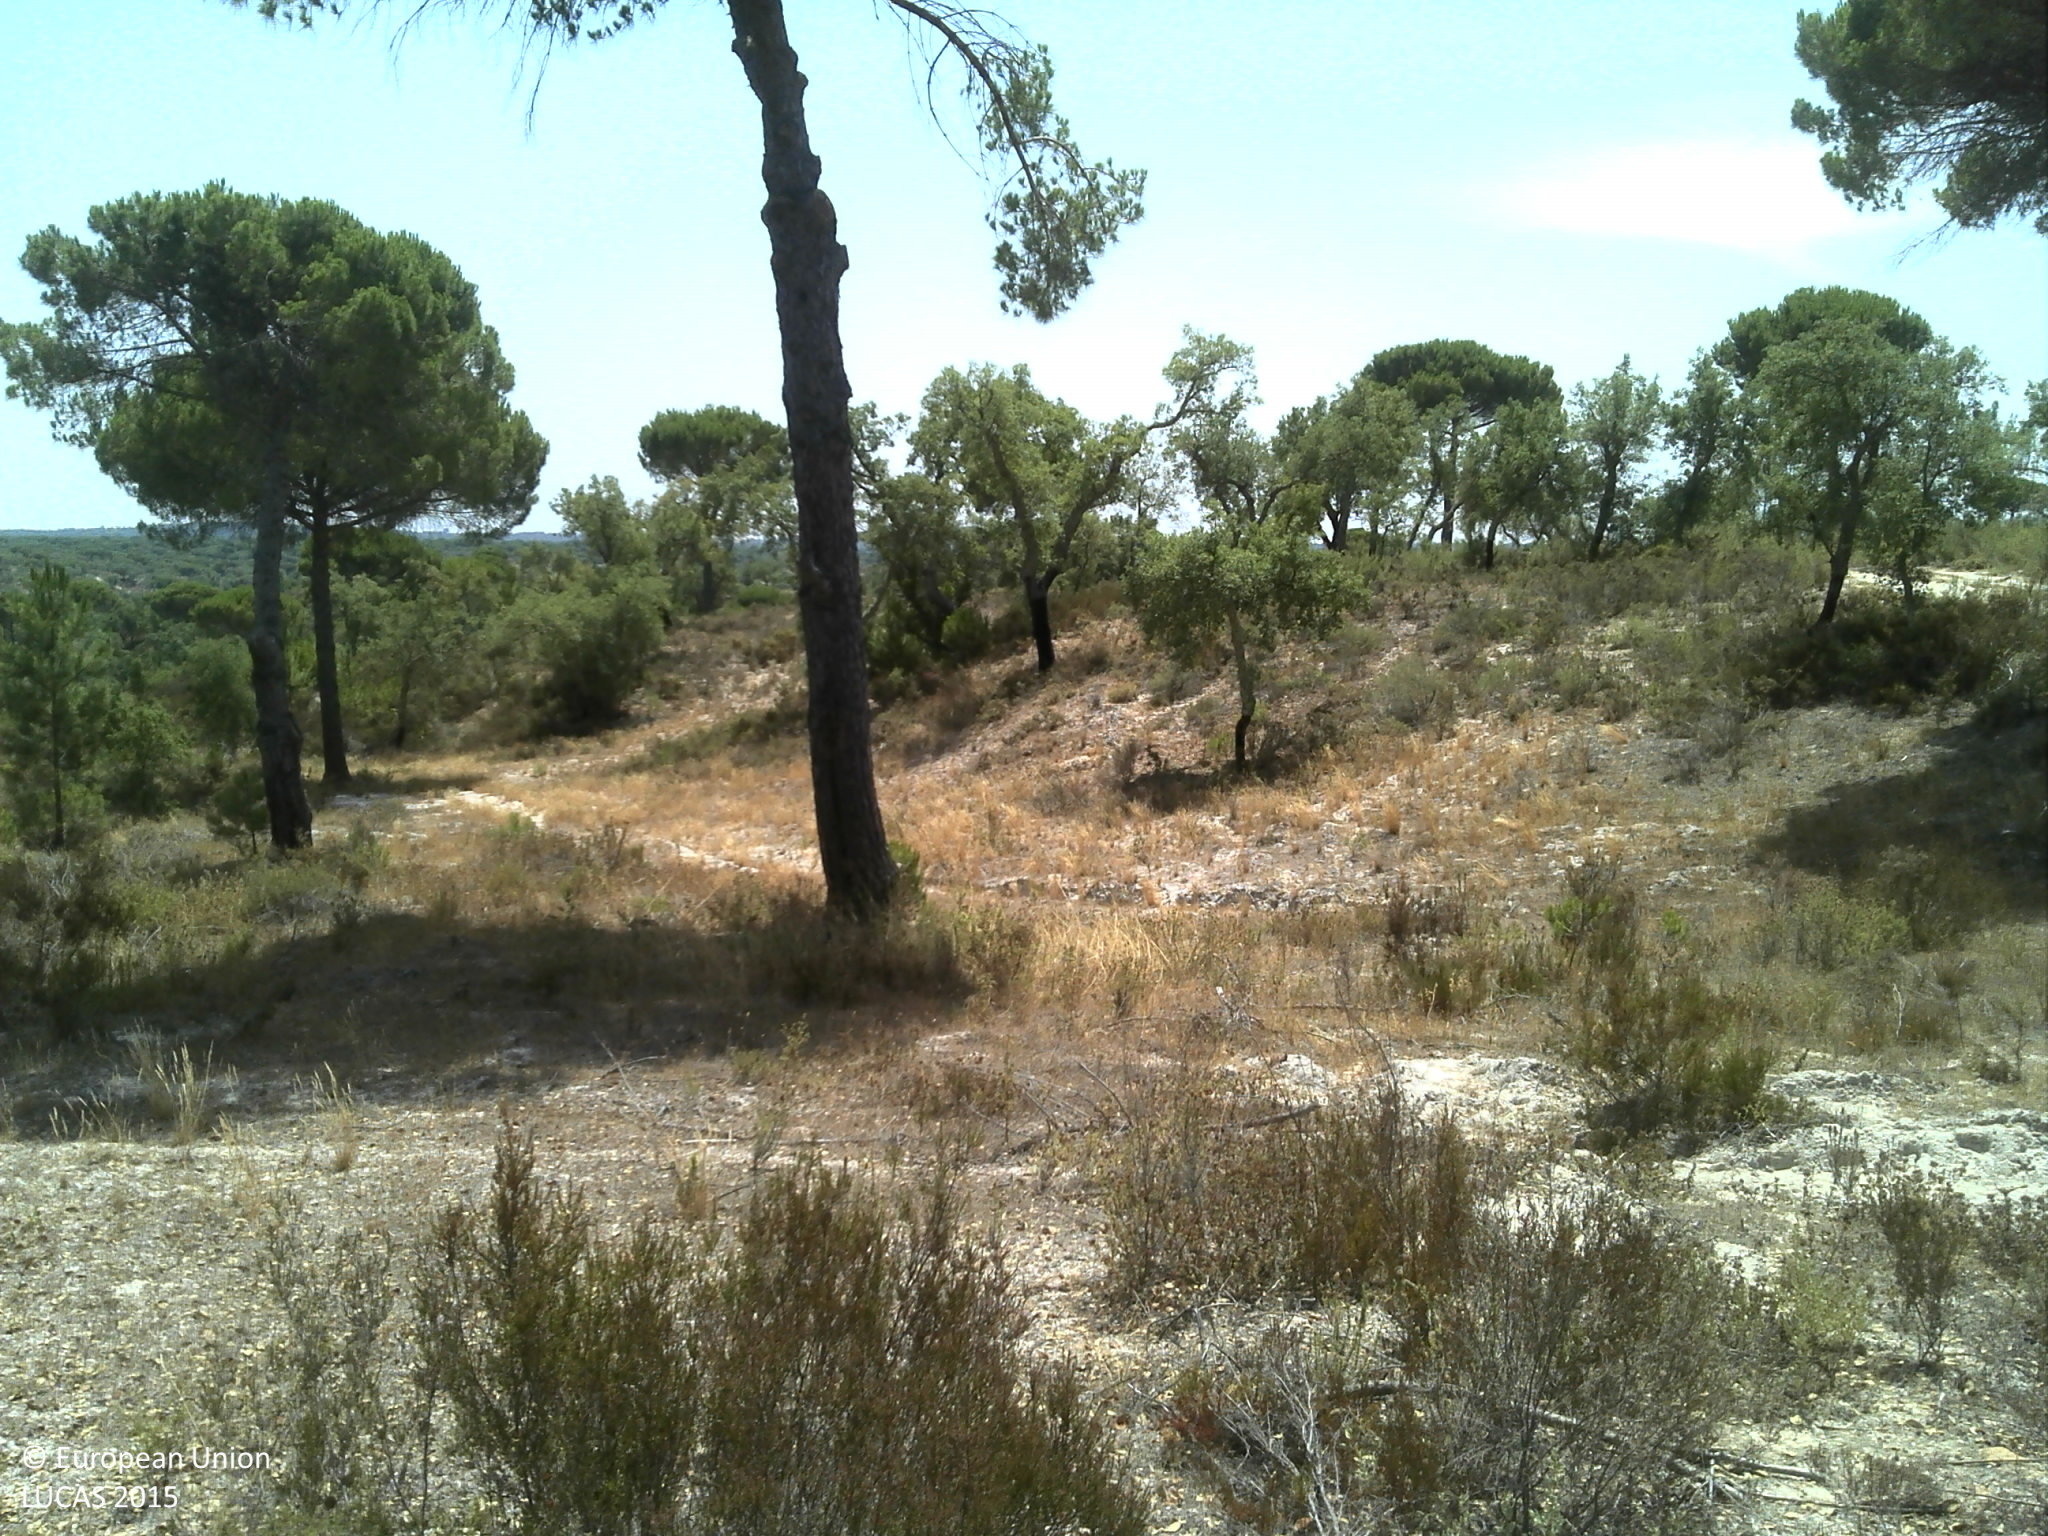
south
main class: Woodland
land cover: Pine dominated coniferous woodland
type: coniferous forest of the mediterranean region
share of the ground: 25 - 50 %
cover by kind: coniferous forest trees 45 %, unconsolidated bare surface 40 %, shrubs 15 %
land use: Forestry
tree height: > 5 m
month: July
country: PT
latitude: 39.1299
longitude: -8.2552
